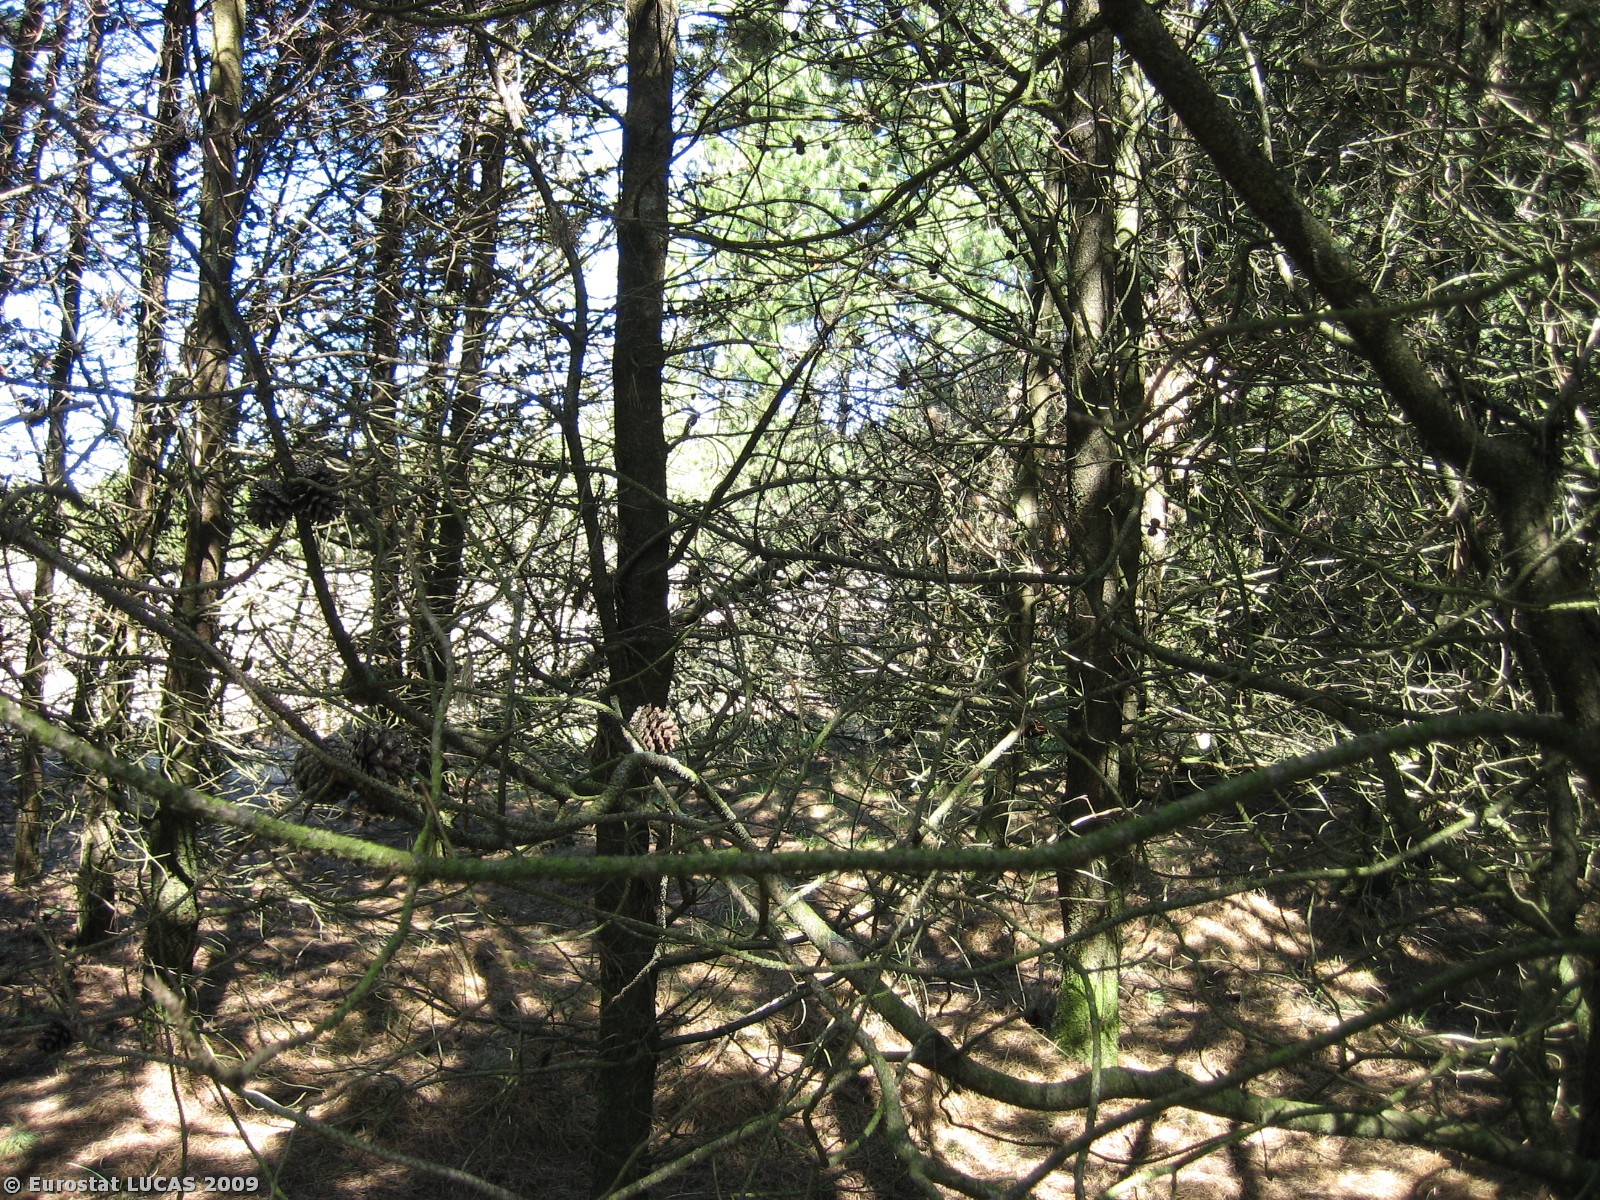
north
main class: Woodland
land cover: Coniferous woodland
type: hemiboreal forest and nemoral coniferous forest and mixed broadleaved-coniferous forest
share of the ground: > 75 %
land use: Forestry
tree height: > 5 m
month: May
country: DK
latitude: 56.2489
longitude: 8.3396
